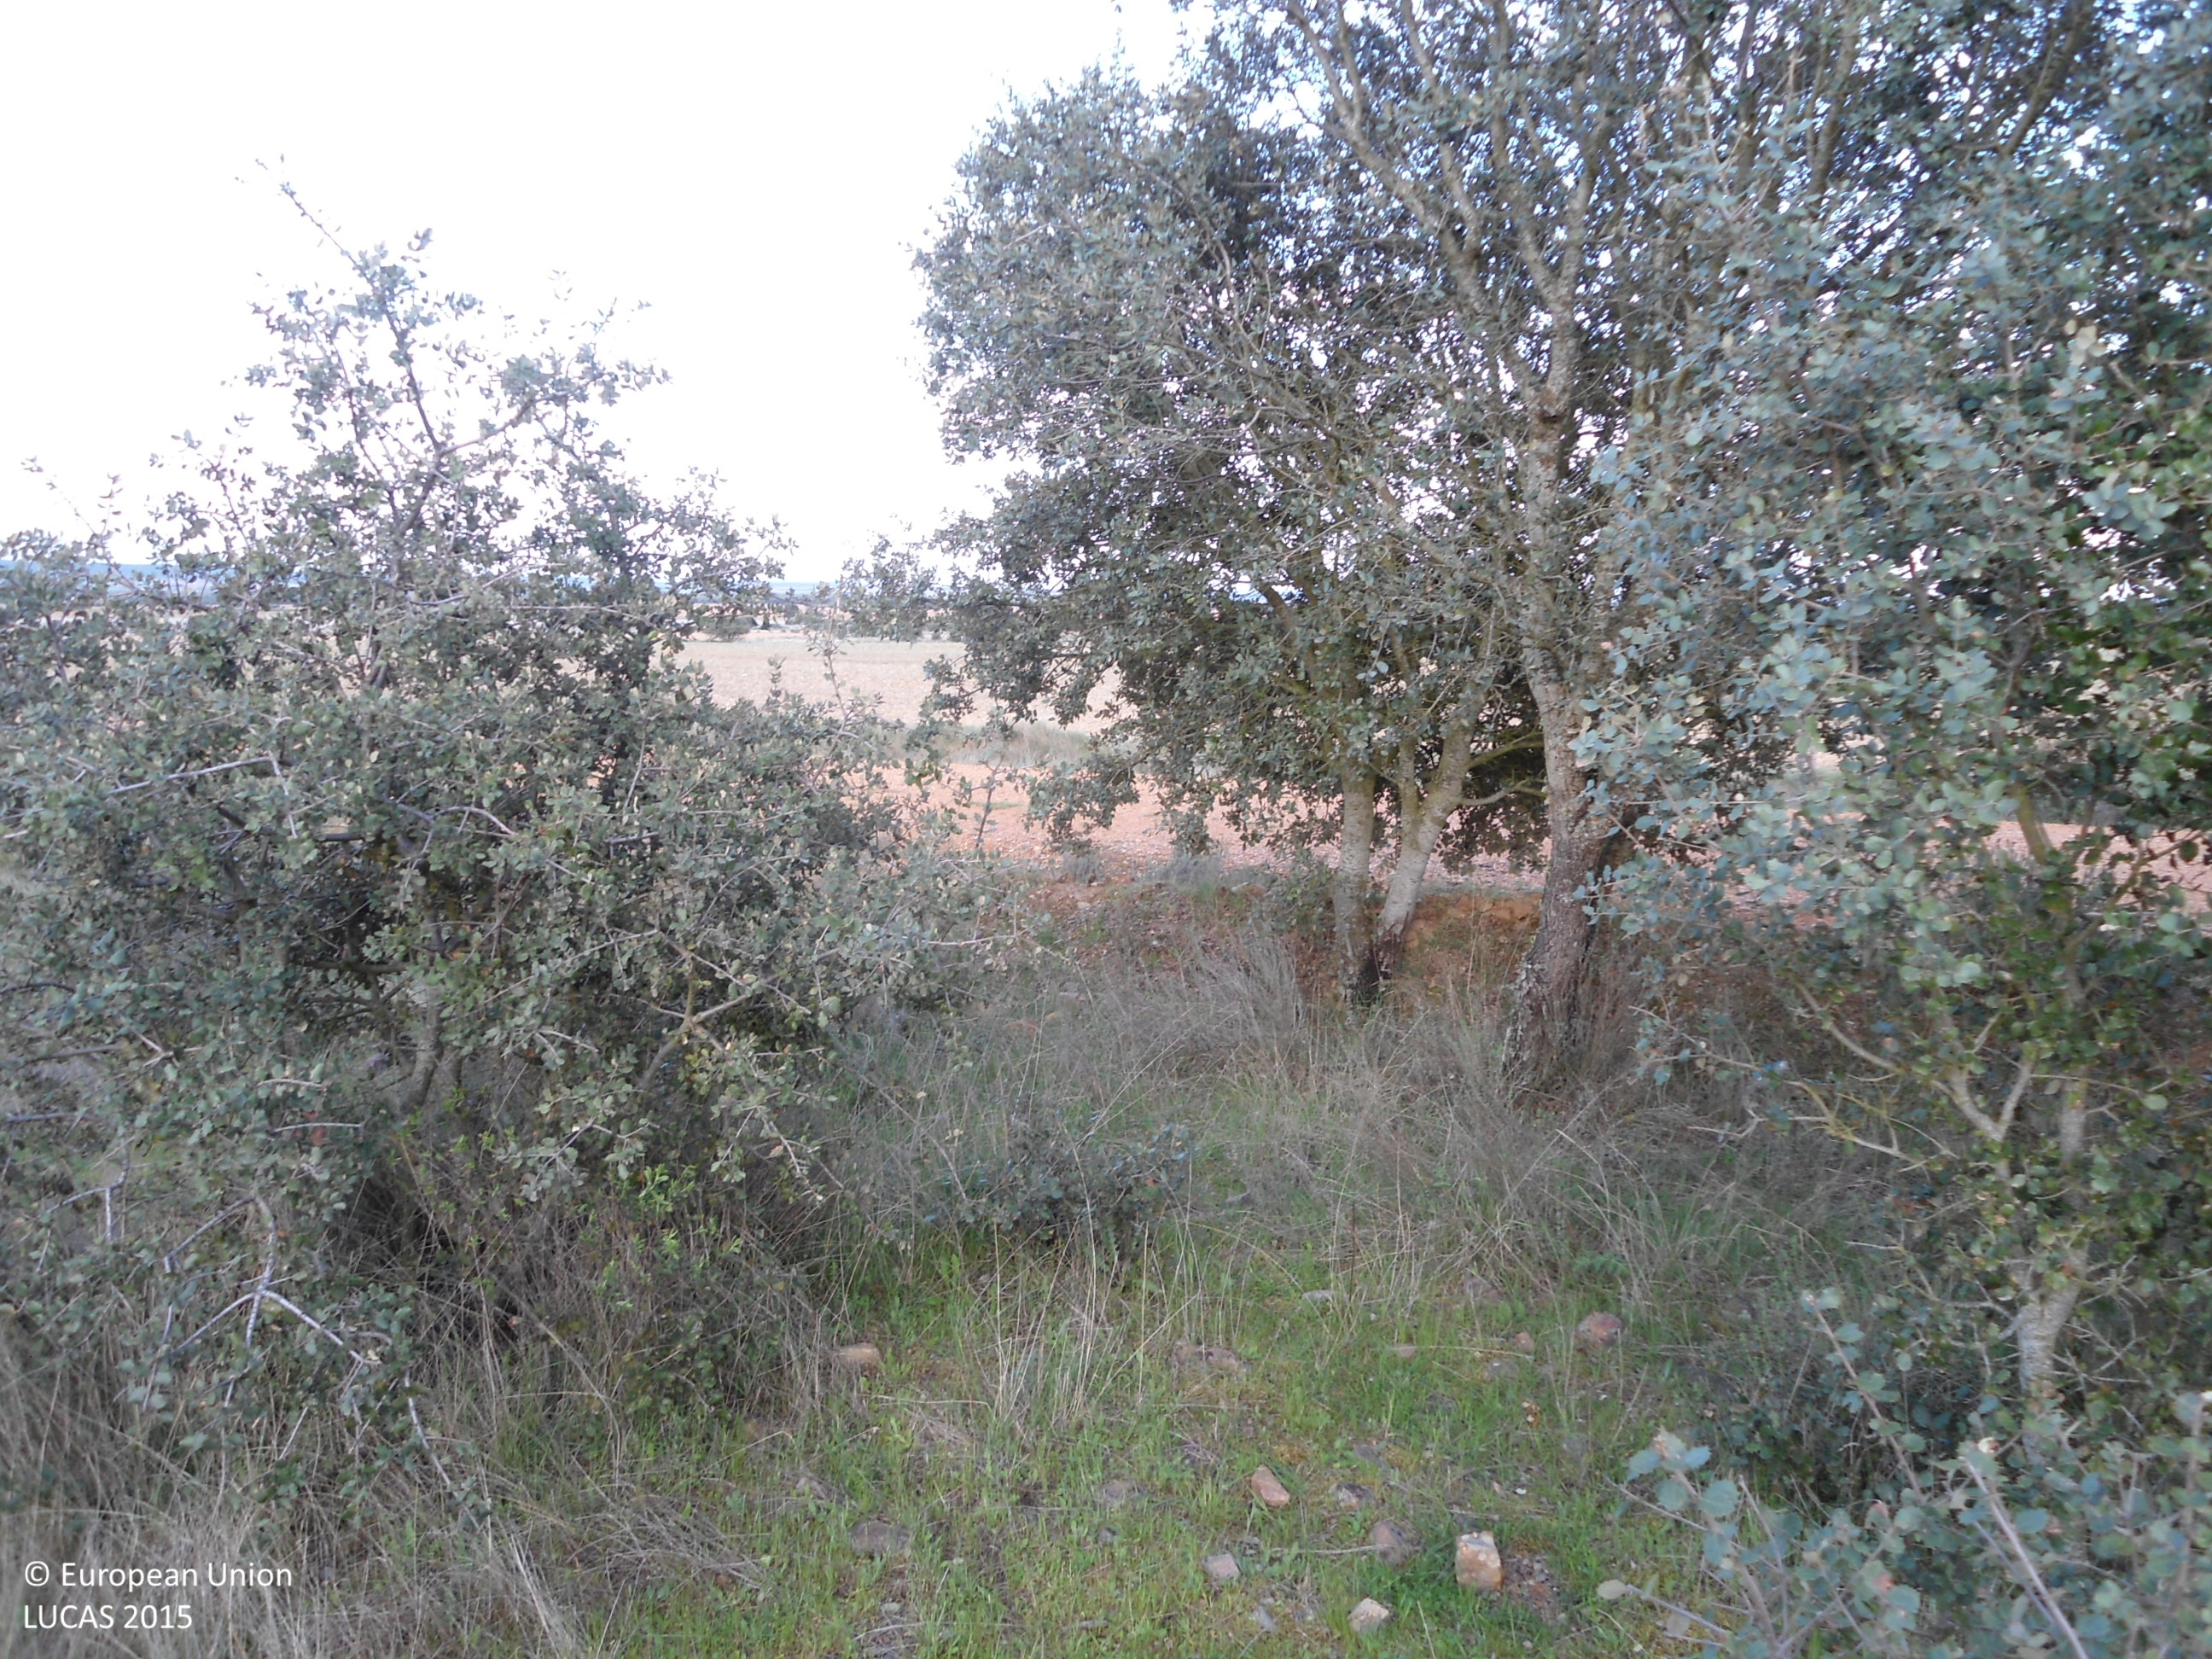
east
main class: Shrubland
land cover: Shrubland with sparse tree cover
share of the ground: > 75 %
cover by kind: shrubs 75 %, herbaceous plants 20 %, broadleaved forest trees 5 %
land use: Agriculture (excluding fallow land and kitchen gardens)
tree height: < 5 m
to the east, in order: Shrubland with sparse tree cover; Grassland with sparse tree/shrub cover; Tracks; Grass margins; Other bare soil; Electric lines; Other bare soil; Shrubland with sparse tree cover
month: April
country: ES
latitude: 41.8000
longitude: -5.9696
